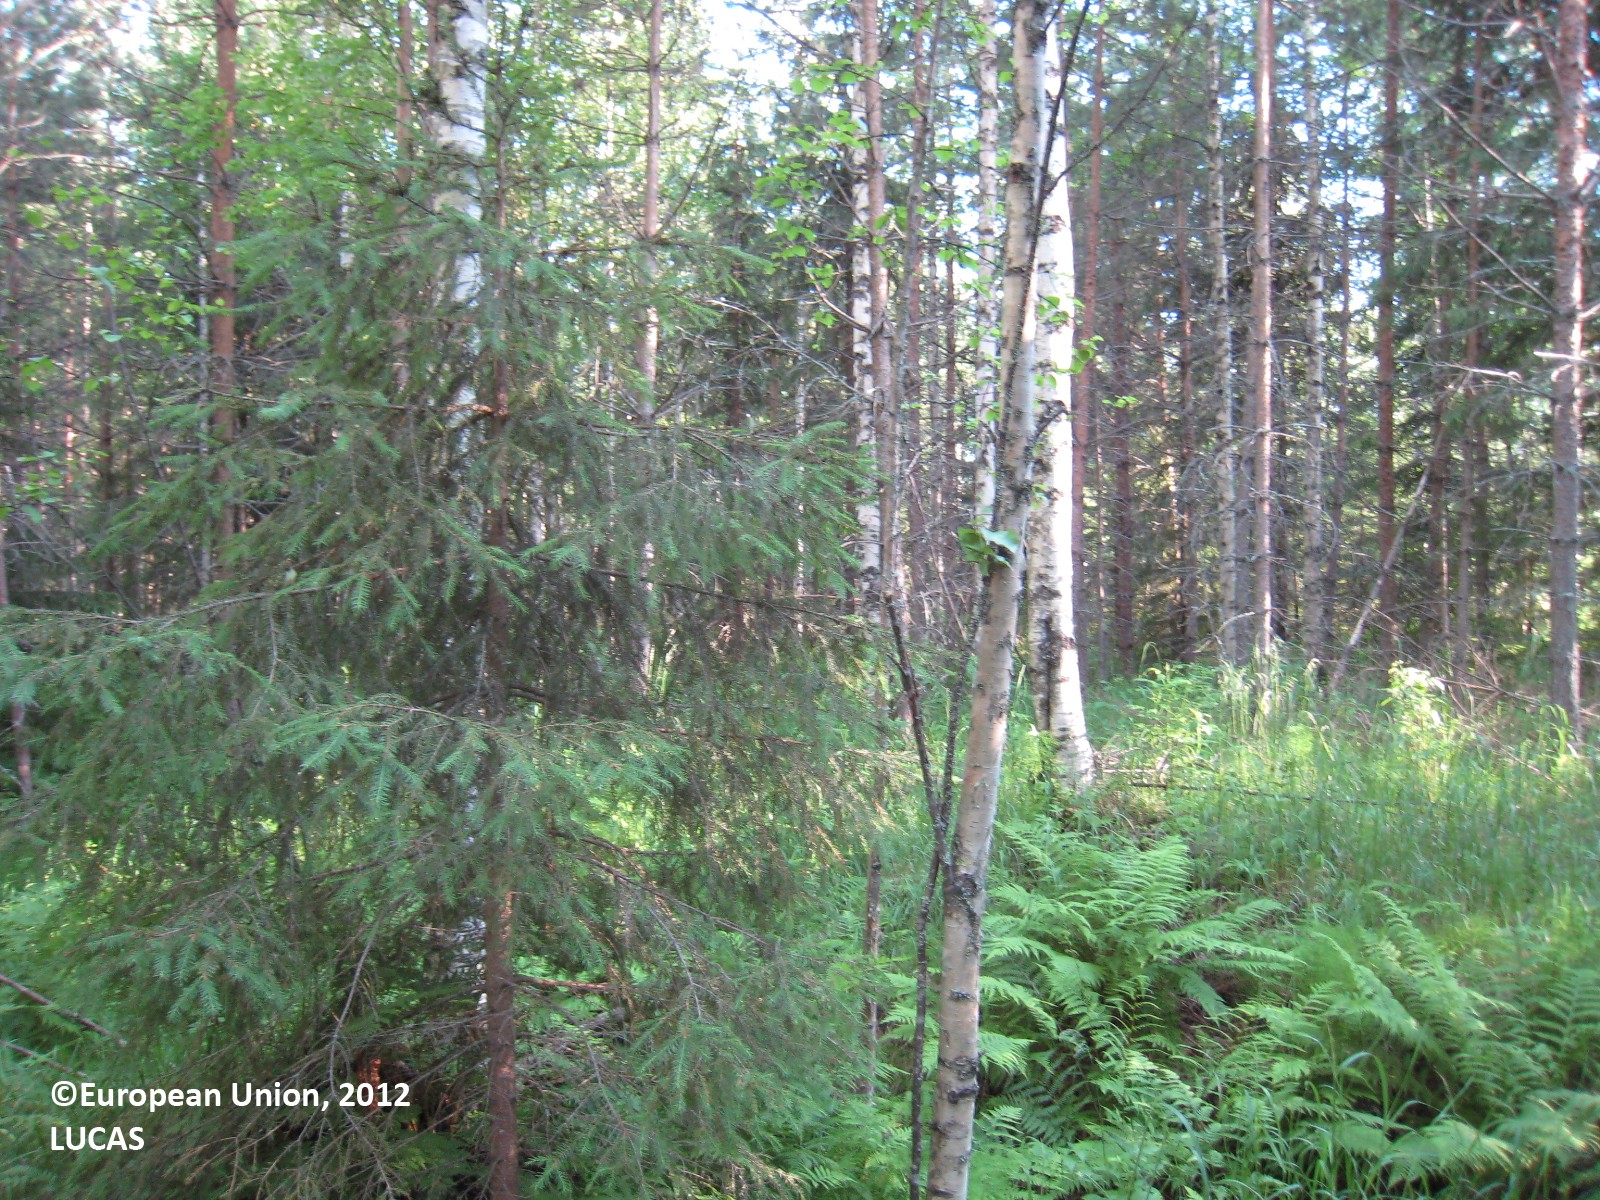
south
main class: Woodland
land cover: Other mixed woodland
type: boreal forest
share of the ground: > 75 %
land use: Forestry
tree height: > 5 m
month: July
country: FI
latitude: 63.1190
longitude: 25.7936
